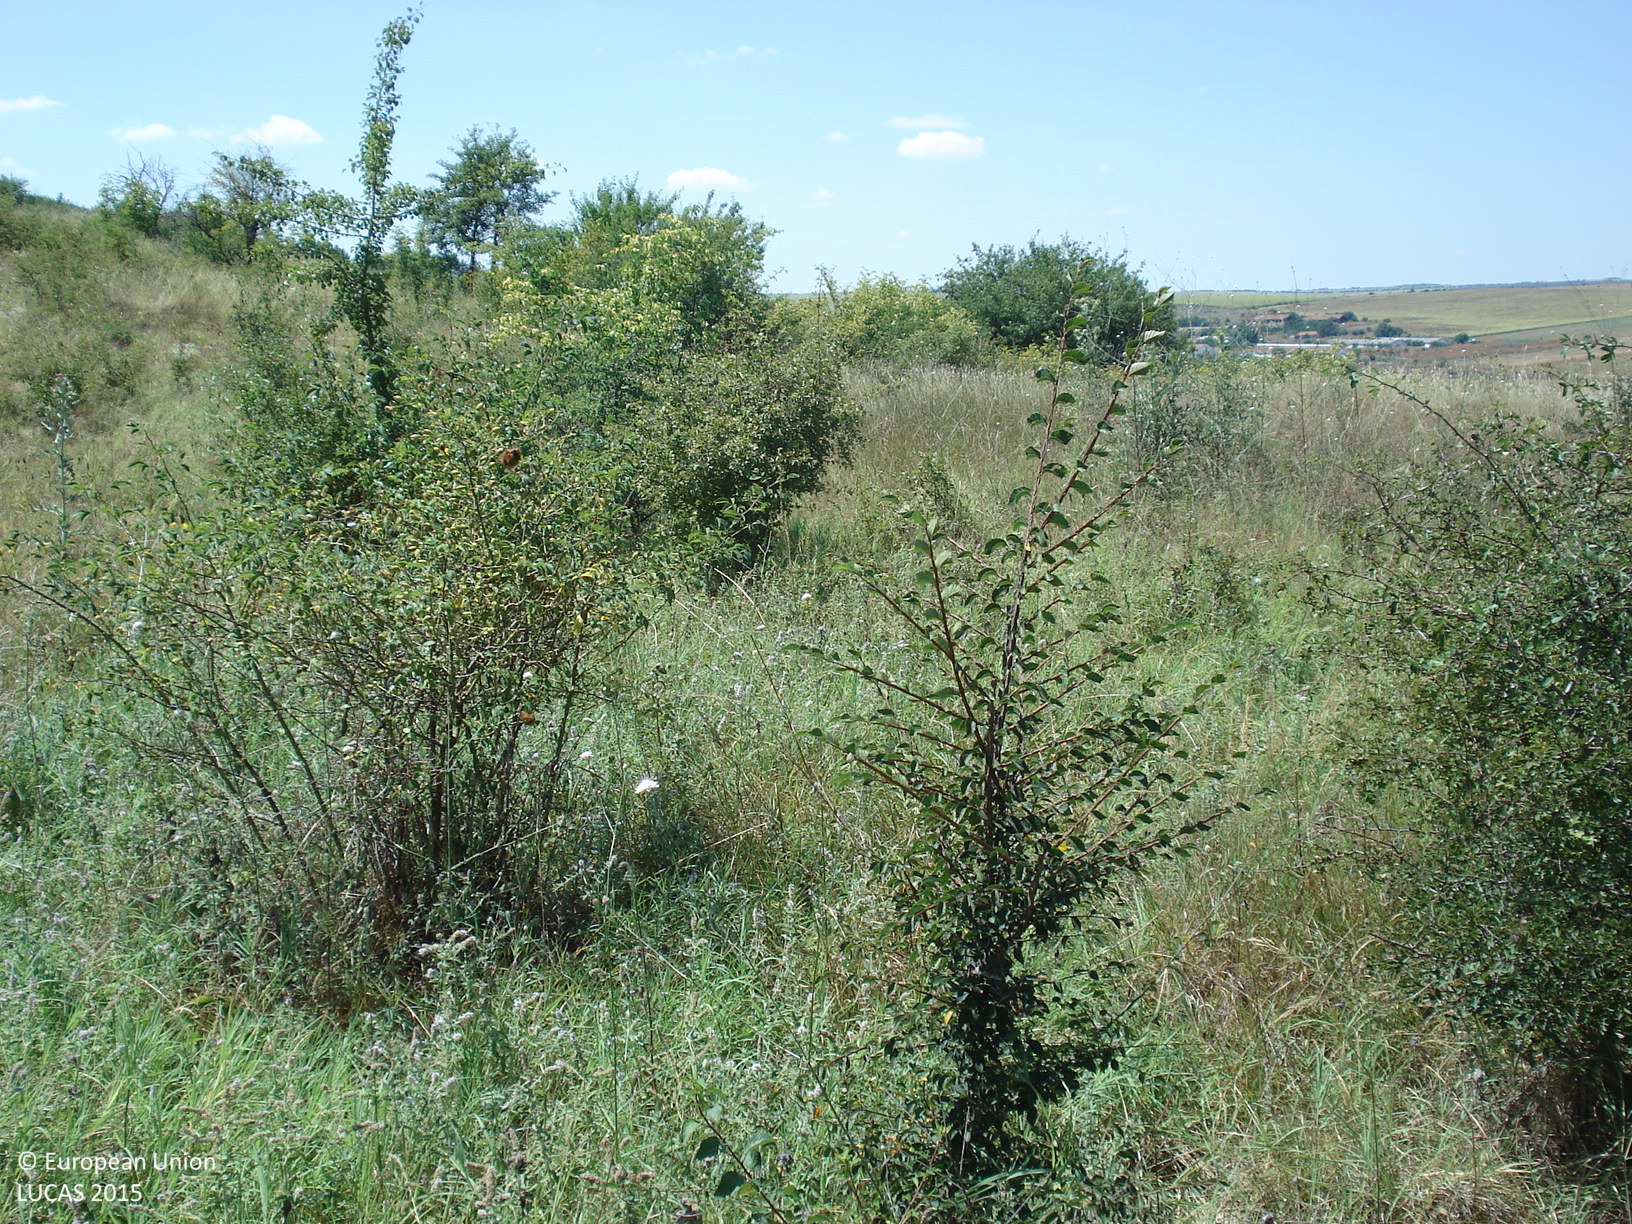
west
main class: Grassland
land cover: Grassland with sparse tree/shrub cover
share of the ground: > 75 %
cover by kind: herbaceous plants 85 %, shrubs 10 %, broadleaved forest trees 5 %
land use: Semi-natural and natural areas not in use
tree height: < 5 m
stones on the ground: < 10 %
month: August
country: BG
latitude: 43.3269
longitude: 25.4823
